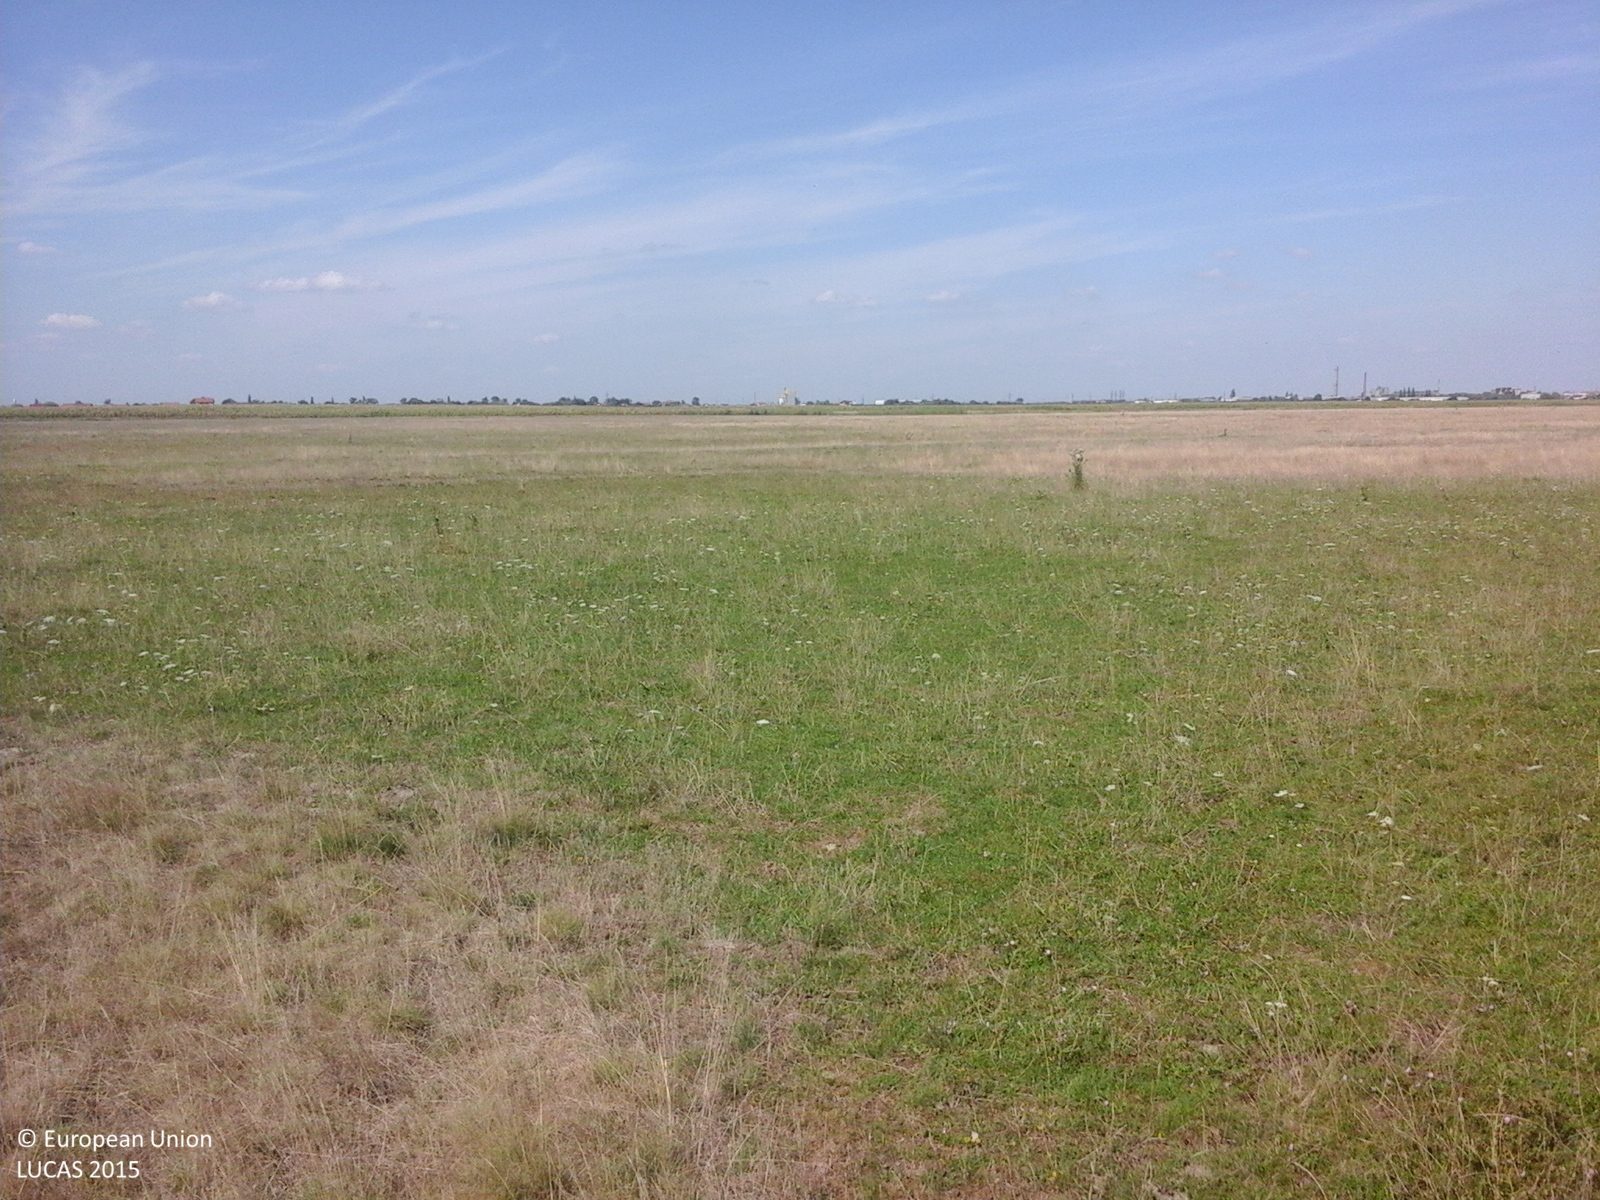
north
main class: Grassland
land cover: Grassland without tree/shrub cover
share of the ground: > 75 %
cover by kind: herbaceous plants 100 %
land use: Agriculture (excluding fallow land and kitchen gardens)
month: August
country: RO
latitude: 45.6949
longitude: 21.1376
